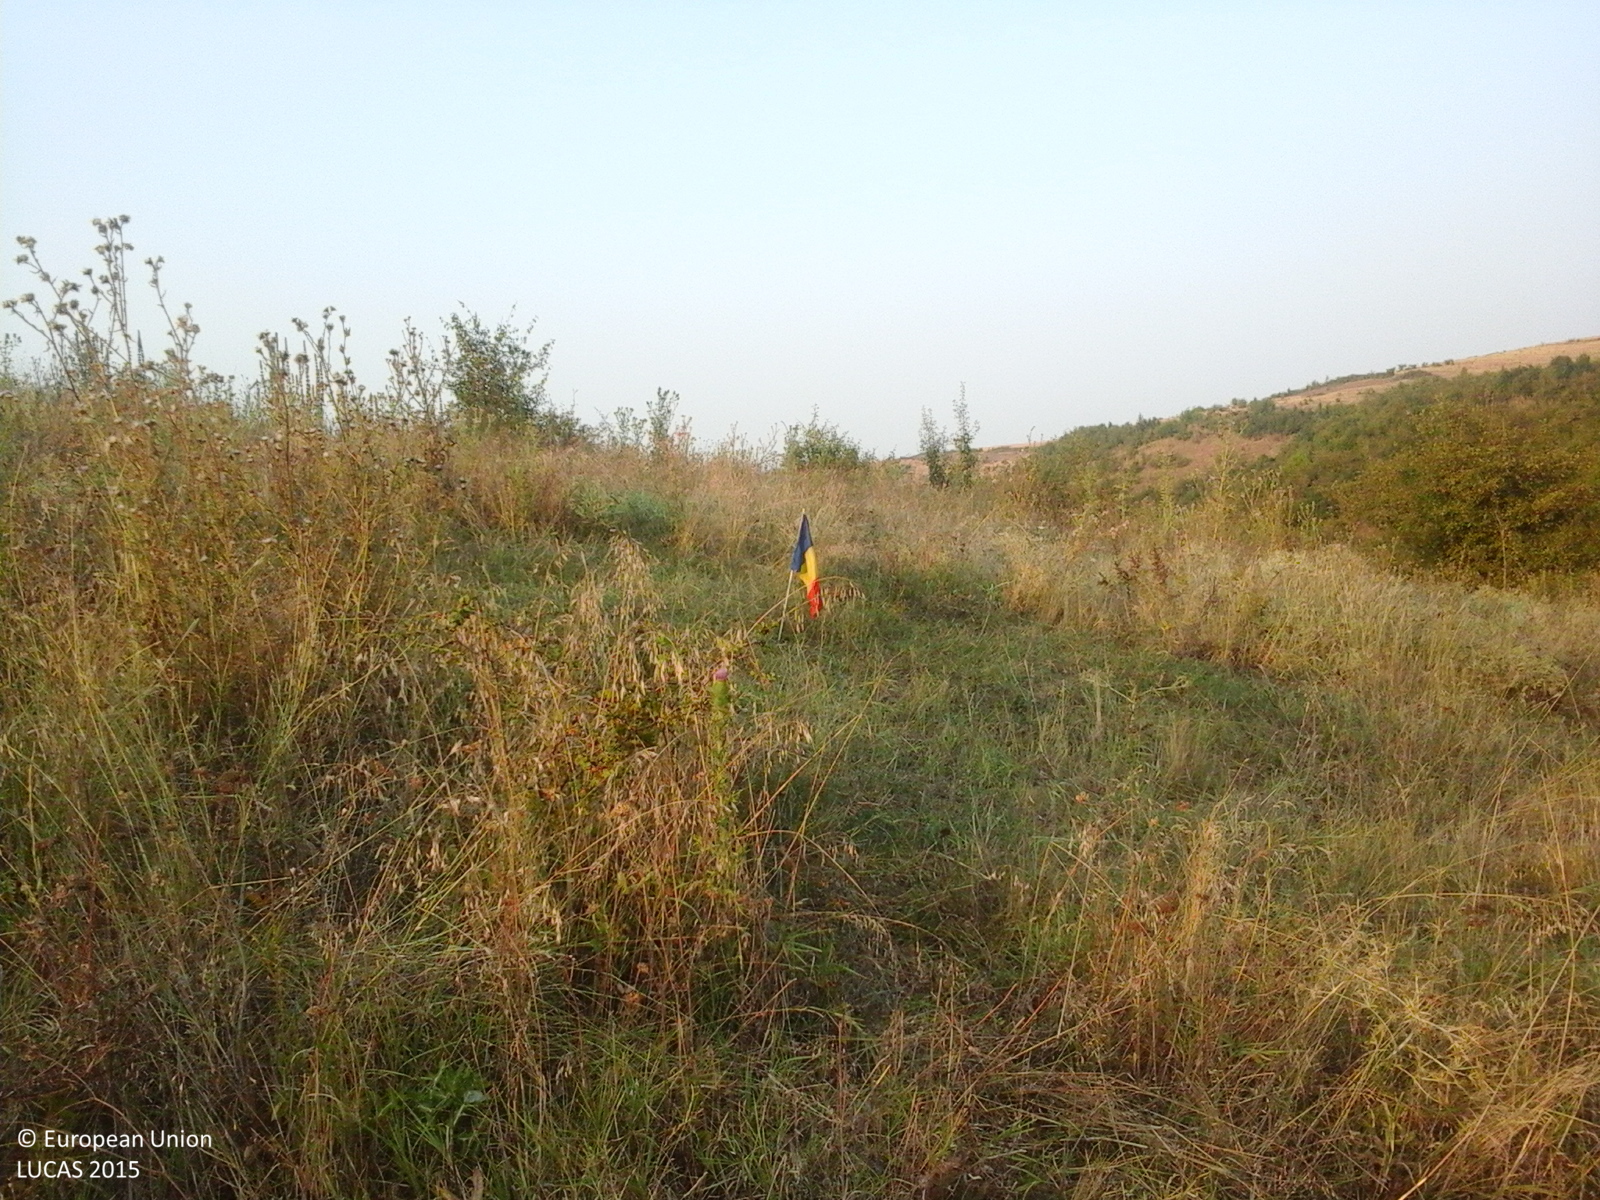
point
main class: Grassland
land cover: Grassland with sparse tree/shrub cover
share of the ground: > 75 %
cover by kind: herbaceous plants 85 %, shrubs 10 %, broadleaved forest trees 5 %
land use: Agriculture (excluding fallow land and kitchen gardens)
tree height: < 5 m
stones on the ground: < 10 %
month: August
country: RO
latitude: 44.3195
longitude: 23.6586
